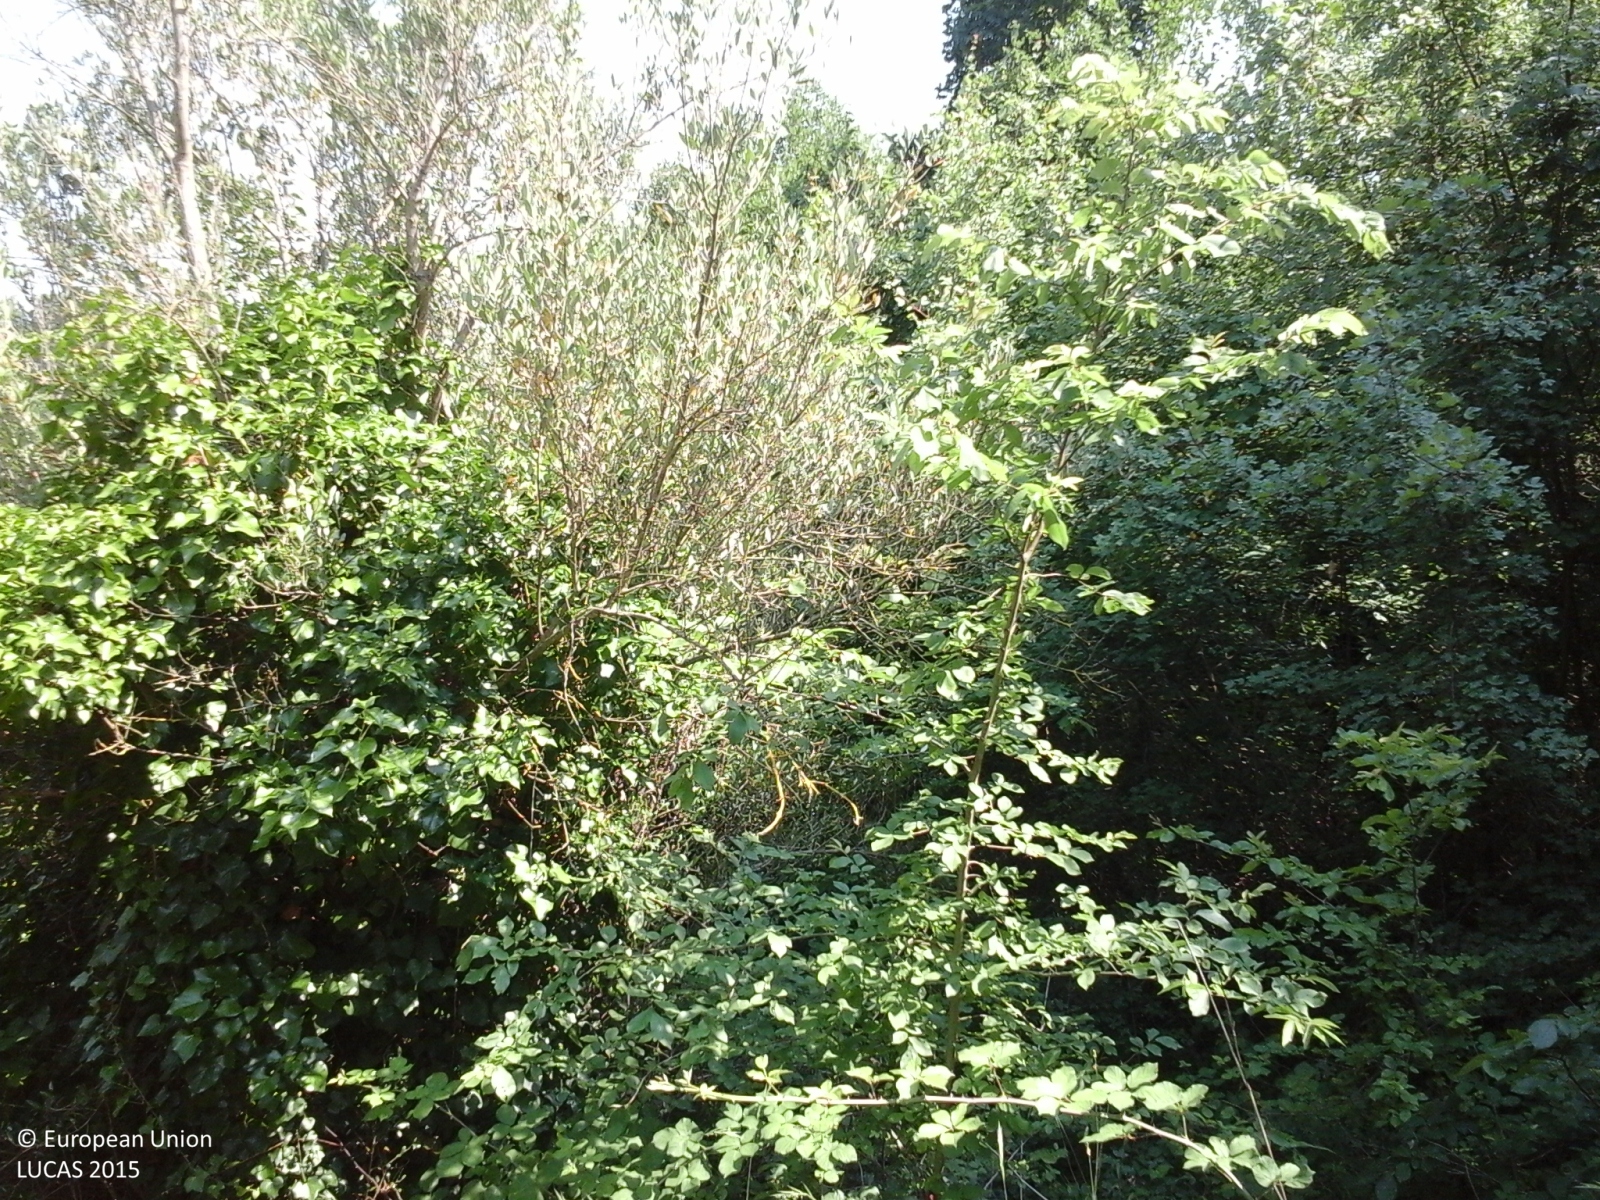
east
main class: Cropland
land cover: Olive groves
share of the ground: 25 - 50 %
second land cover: Spontaneously vegetated surfaces
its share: 25 - 50 %
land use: Abandoned areas
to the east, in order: Olive groves; Spontaneously vegetated surfaces; Broadleaved woodland; Tracks; Shrubland without tree cover; Rivers and streams; Shrubland with sparse tree cover; Electric lines; Grassland without tree/shrub cover; Abandoned hedges; Tracks; Grass margins; Single bushes/trees; Other leguminous and mixtures for fodder; Spontaneously vegetated surfaces; Abandoned hedges; Olive groves
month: June
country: IT
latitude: 42.1062
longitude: 14.4001
